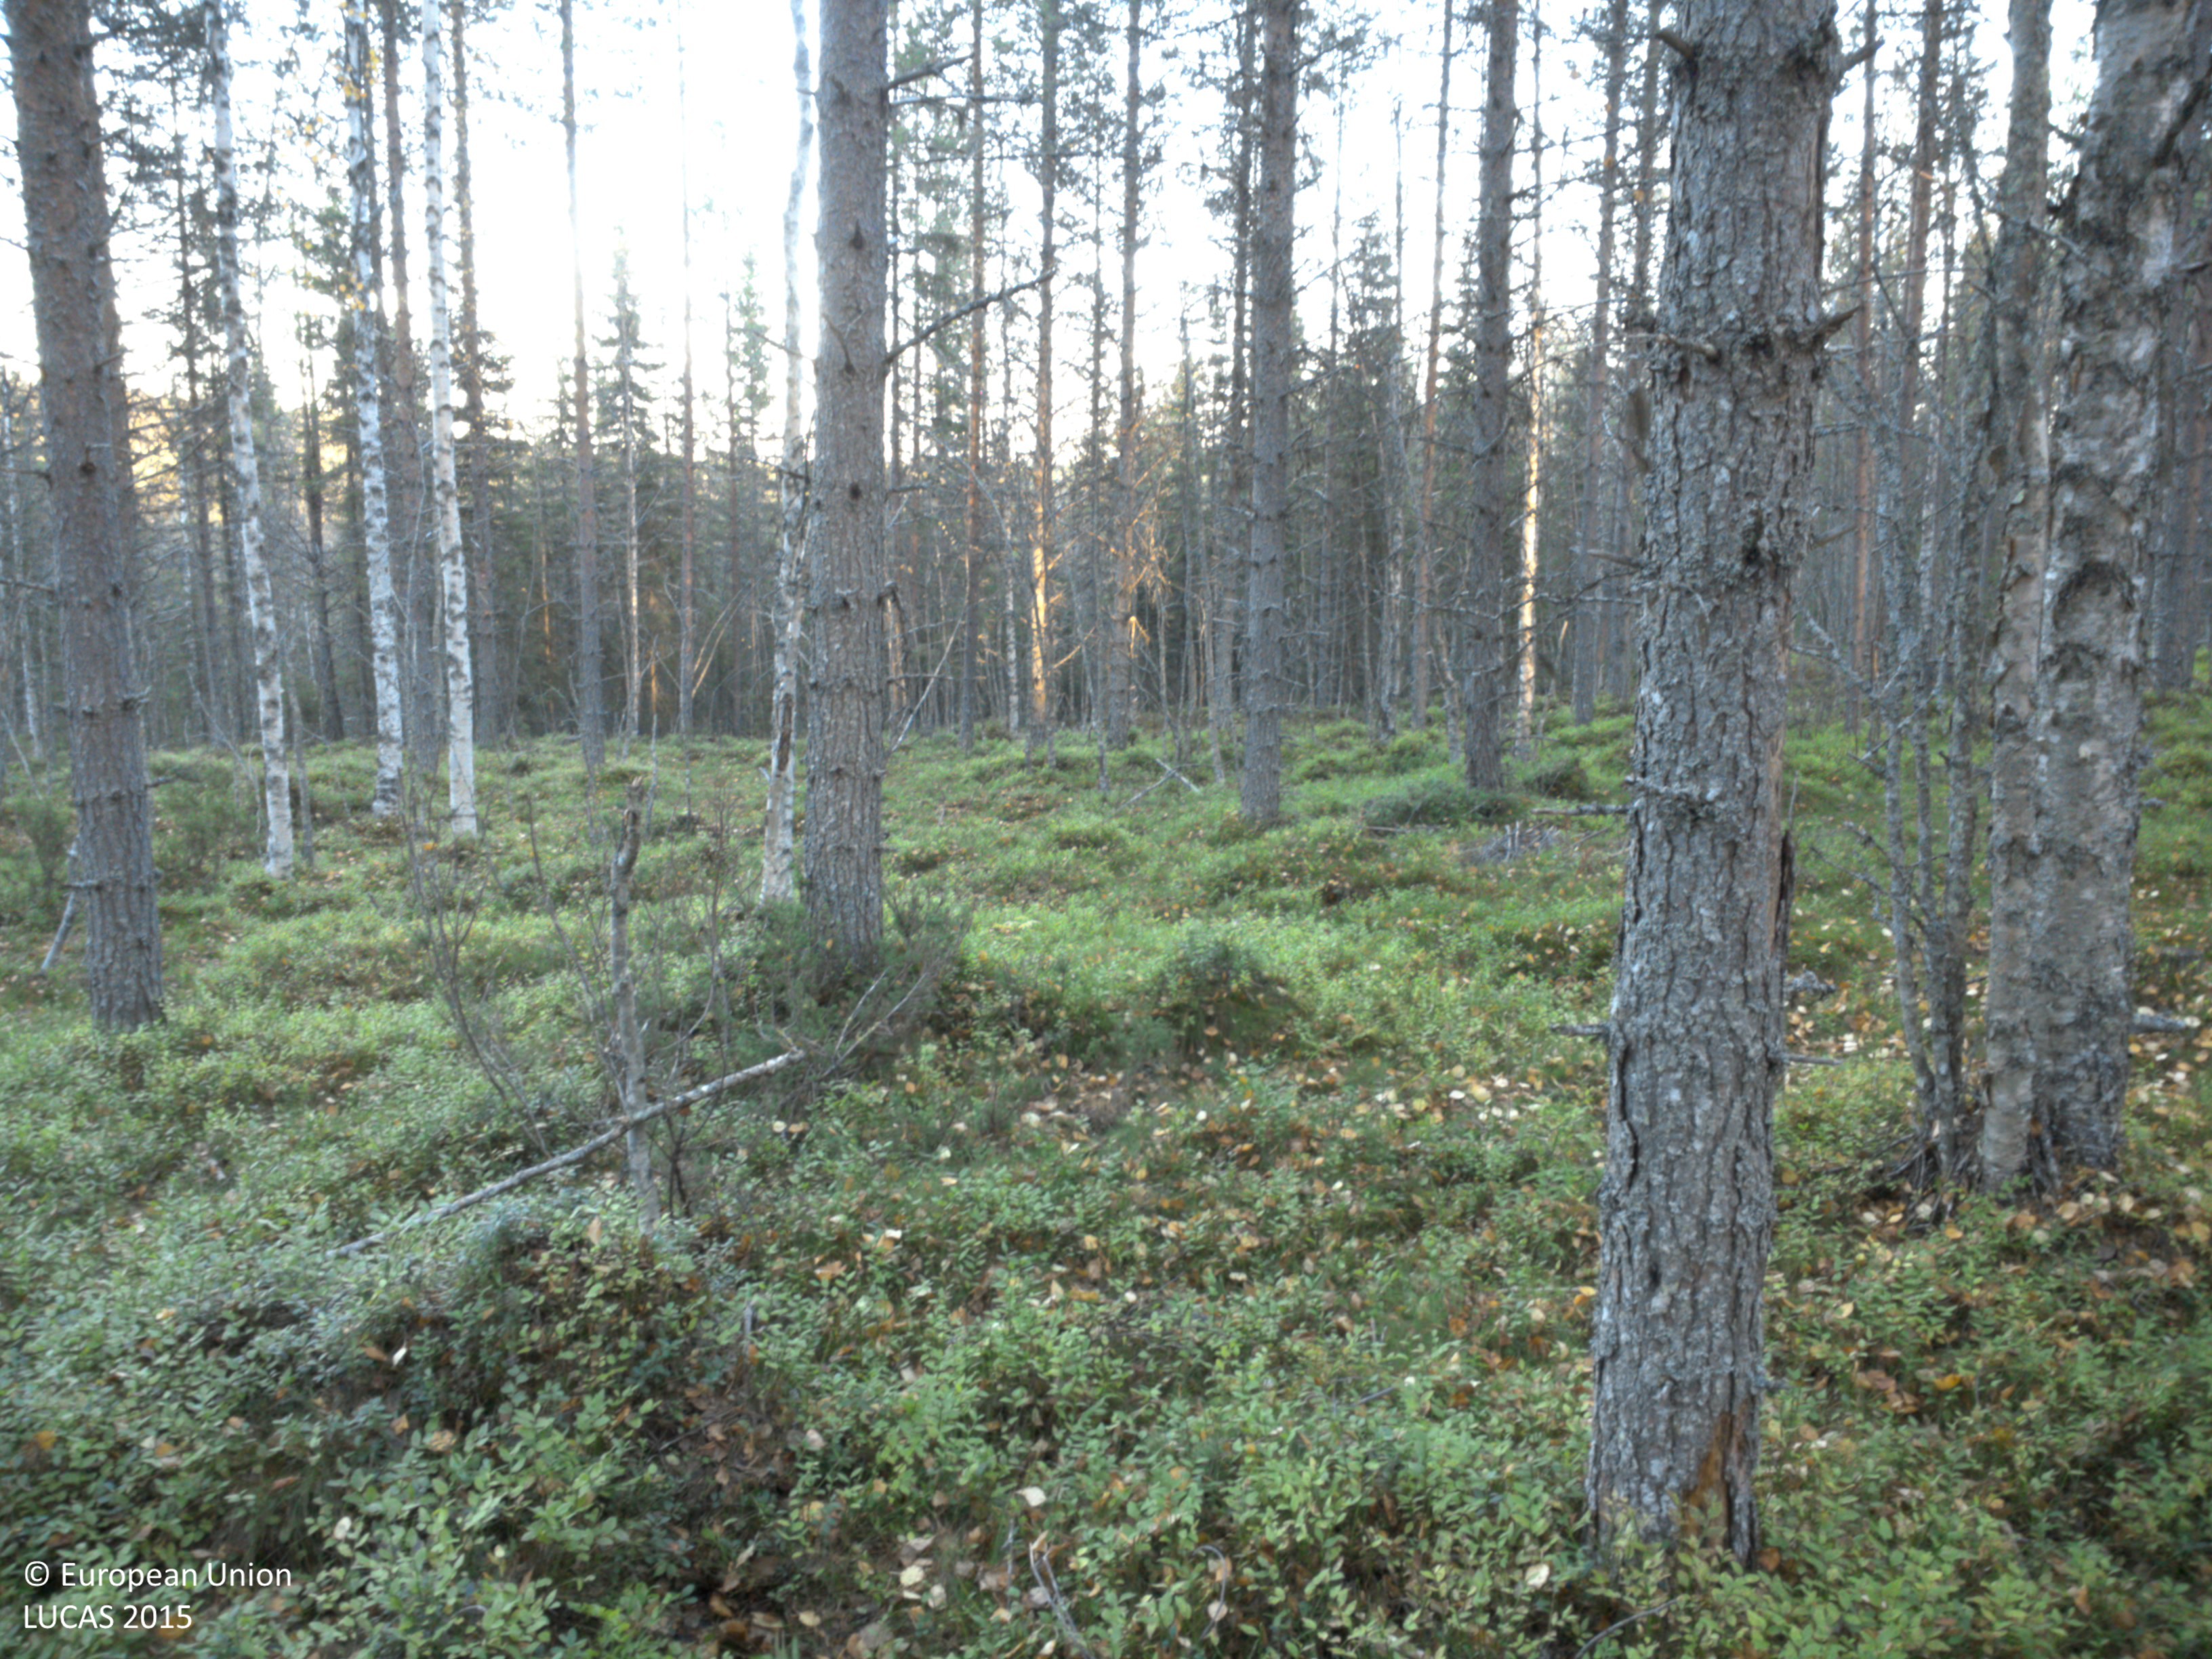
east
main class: Woodland
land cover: Pine dominated coniferous woodland
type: boreal forest
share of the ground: 50 - 75 %
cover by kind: coniferous forest trees 60 %, shrubs 20 %, lichens and mosses 15 %, broadleaved forest trees 5 %
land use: Forestry
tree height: > 5 m
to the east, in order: Pine dominated coniferous woodland; Pine dominated mixed woodland; Spruce dominated mixed woodland; Ponds and wetlands; Spruce dominated coniferous woodland; Spruce dominated mixed woodland
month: October
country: SE
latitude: 64.7171
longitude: 17.7512
